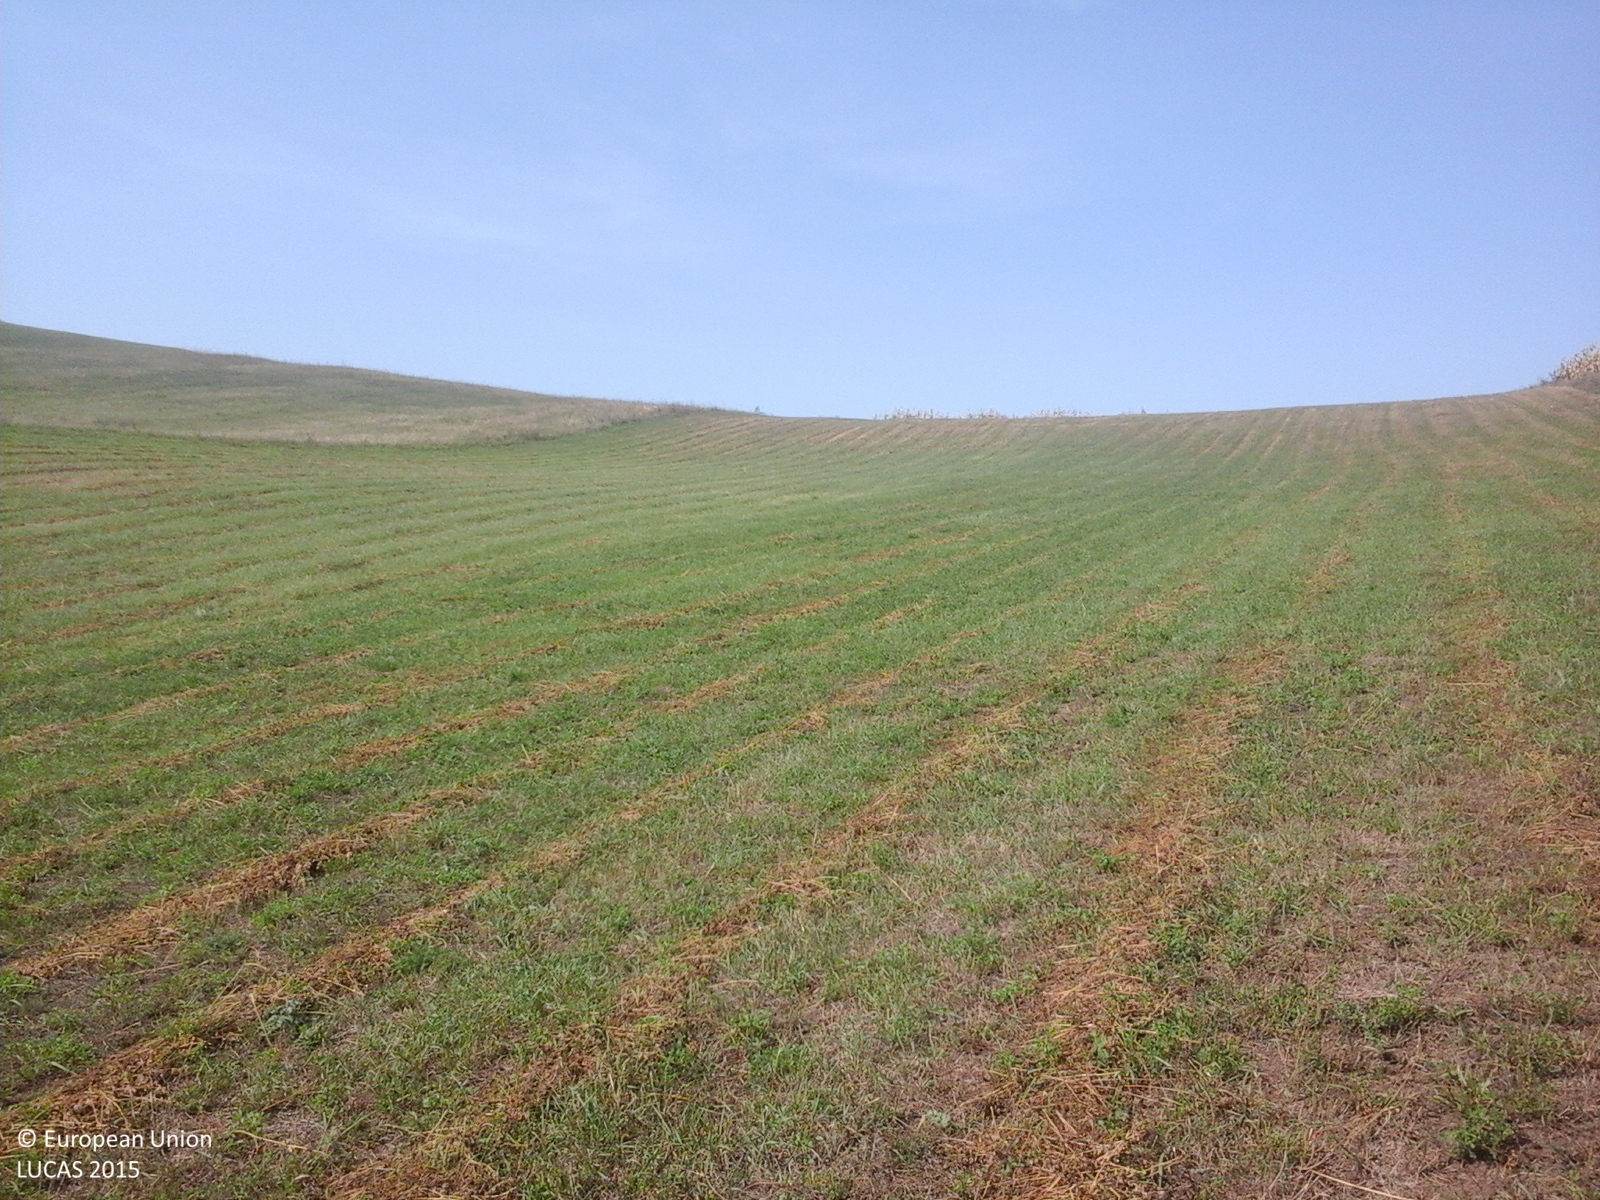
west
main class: Cropland
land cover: Lucerne
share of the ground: > 75 %
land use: Agriculture (excluding fallow land and kitchen gardens)
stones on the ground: < 10 %
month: September
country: RO
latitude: 46.6538
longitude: 24.1009
